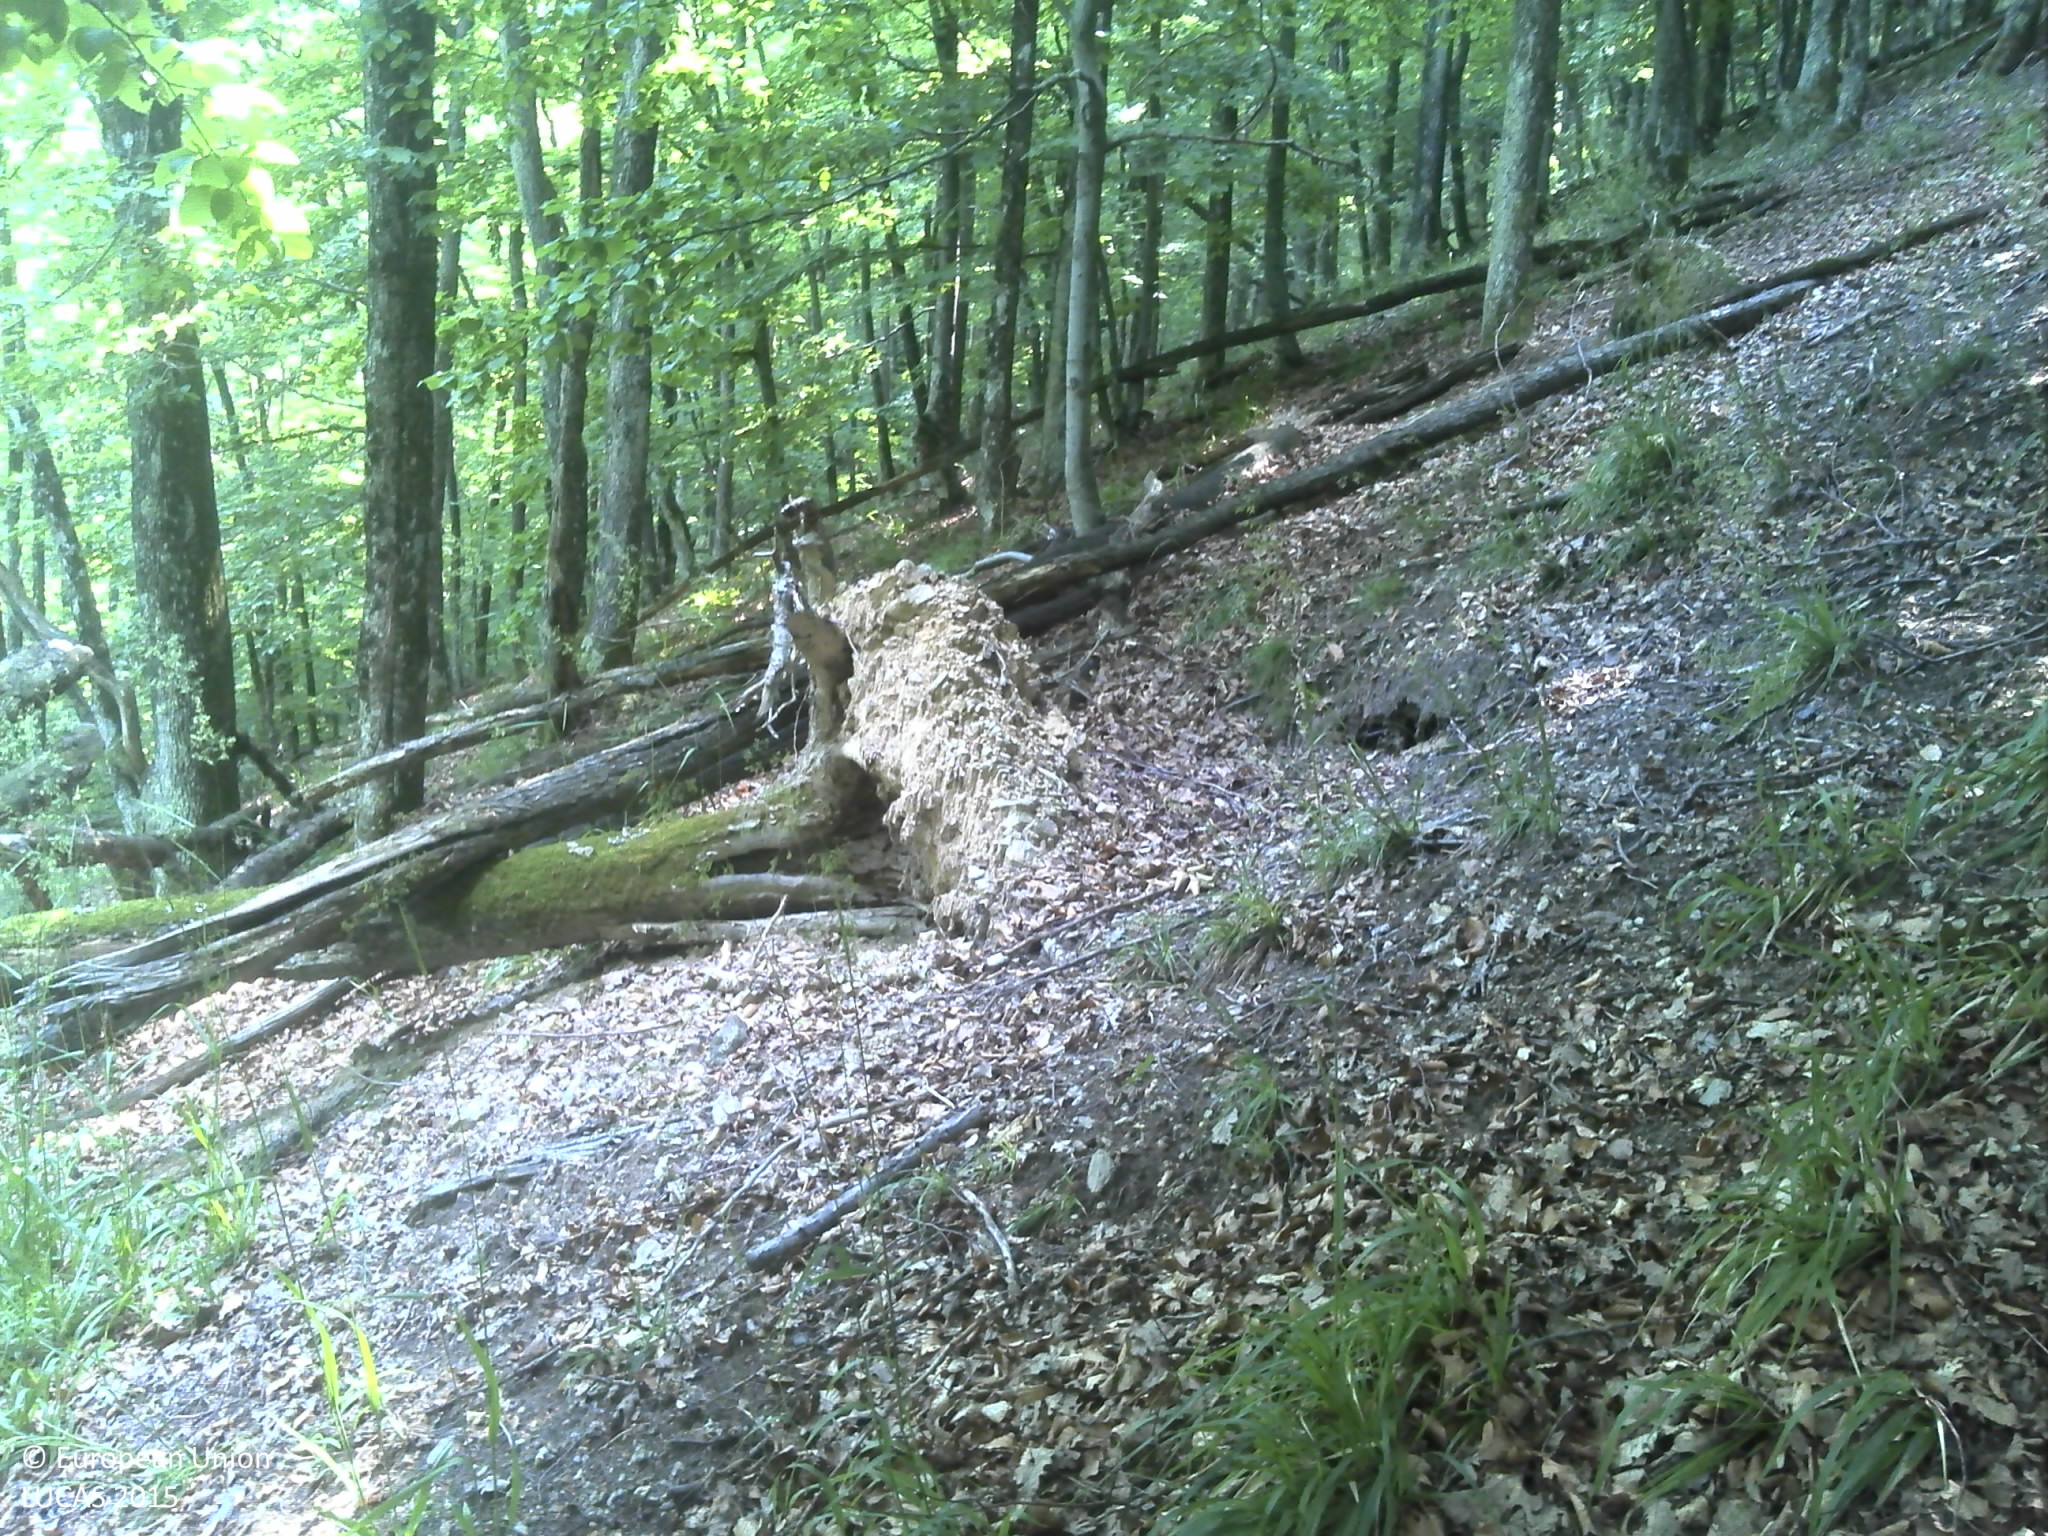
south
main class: Woodland
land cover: Broadleaved woodland
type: beech forest
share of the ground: > 75 %
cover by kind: broadleaved forest trees 90 %, shrubs 5 %, herbaceous plants 5 %
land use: Forestry
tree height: > 5 m
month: June
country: HR
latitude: 45.5289
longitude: 17.7235
